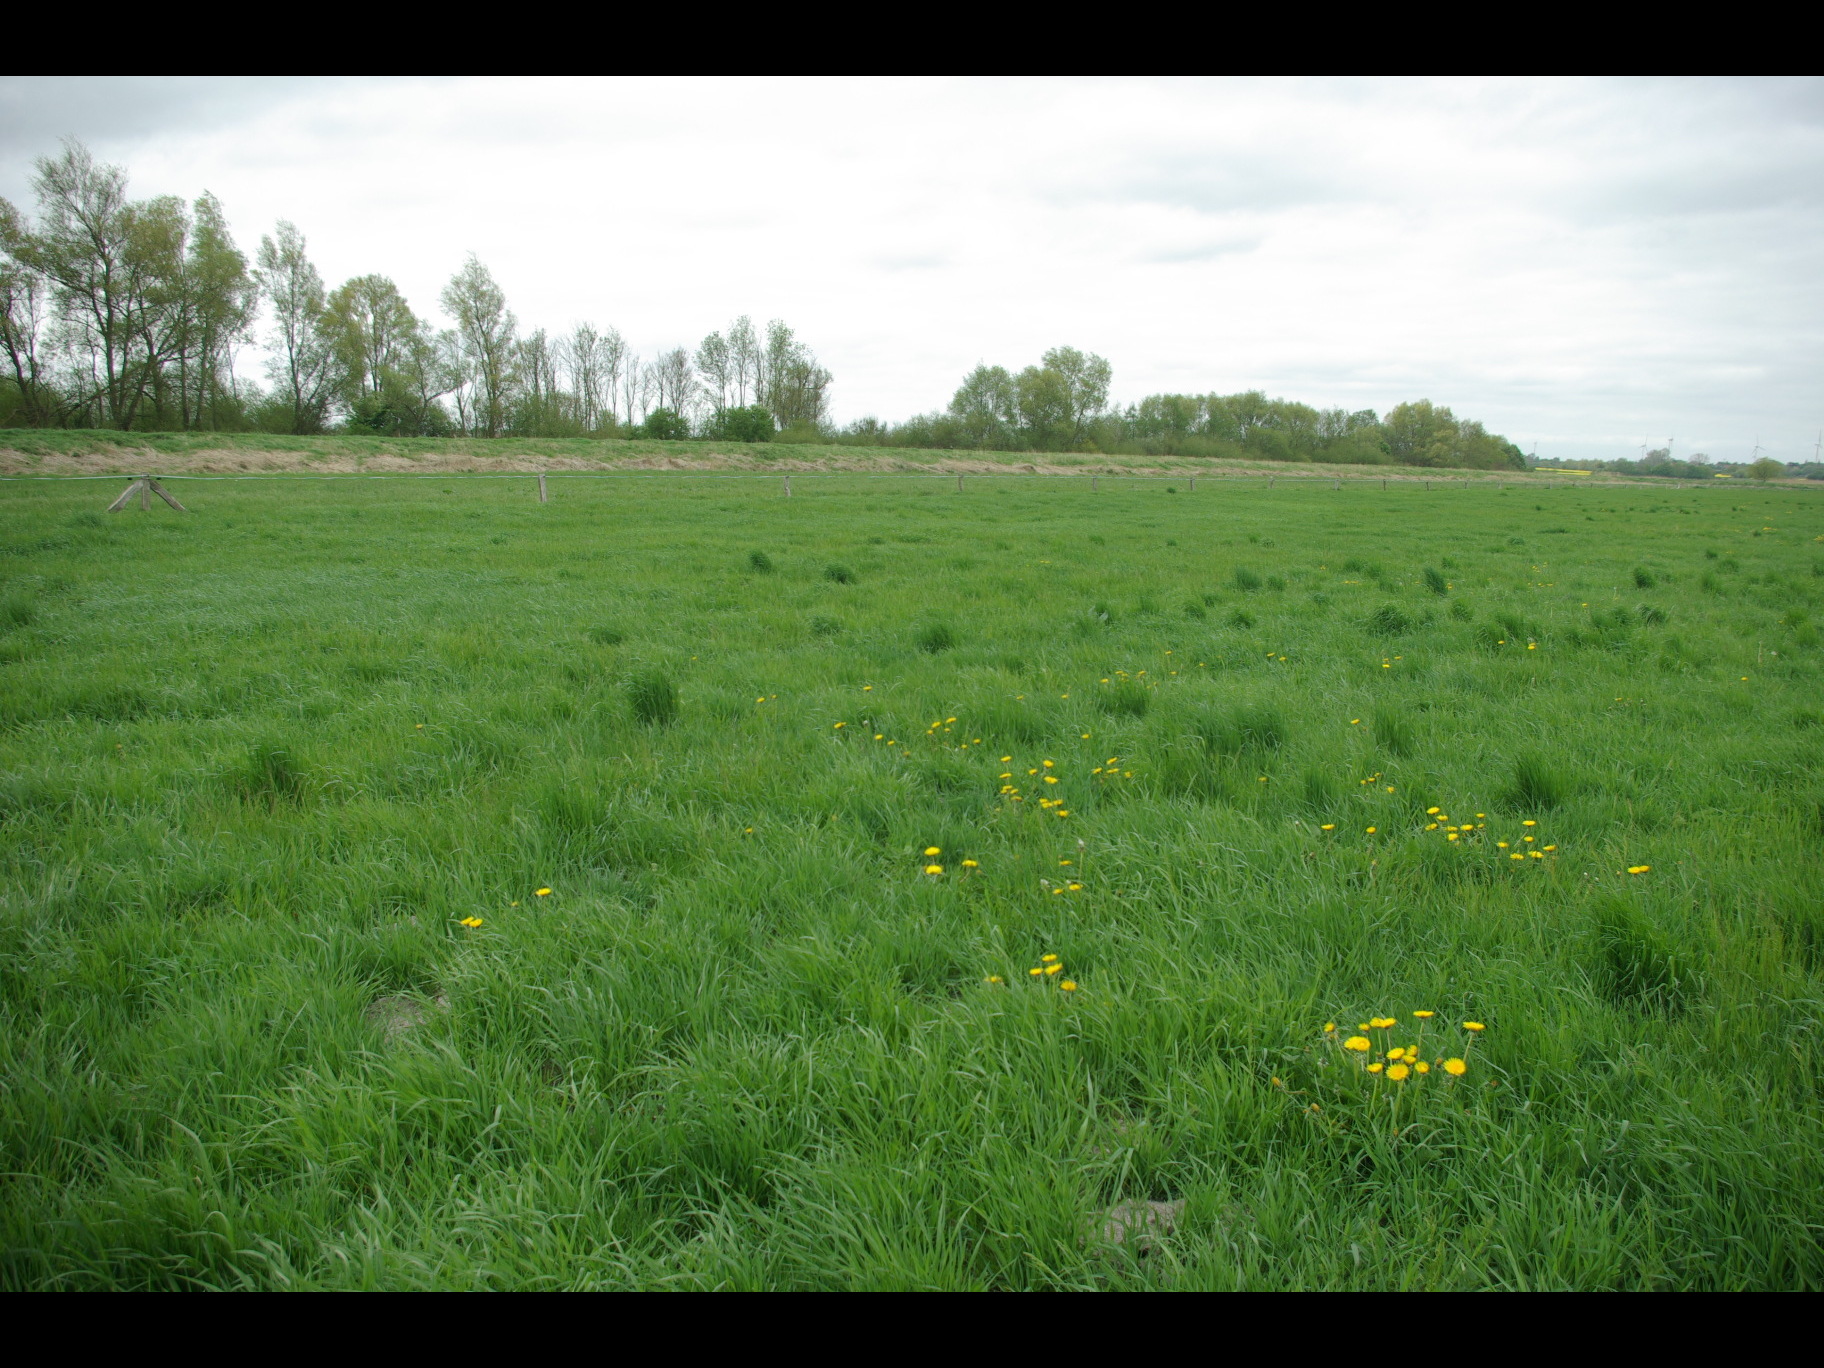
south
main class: Grassland
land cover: Grassland without tree/shrub cover
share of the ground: > 75 %
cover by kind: herbaceous plants 95 %, unconsolidated bare surface 5 %
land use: Agriculture (excluding fallow land and kitchen gardens)
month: May
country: DE
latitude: 54.2426
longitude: 10.9968
